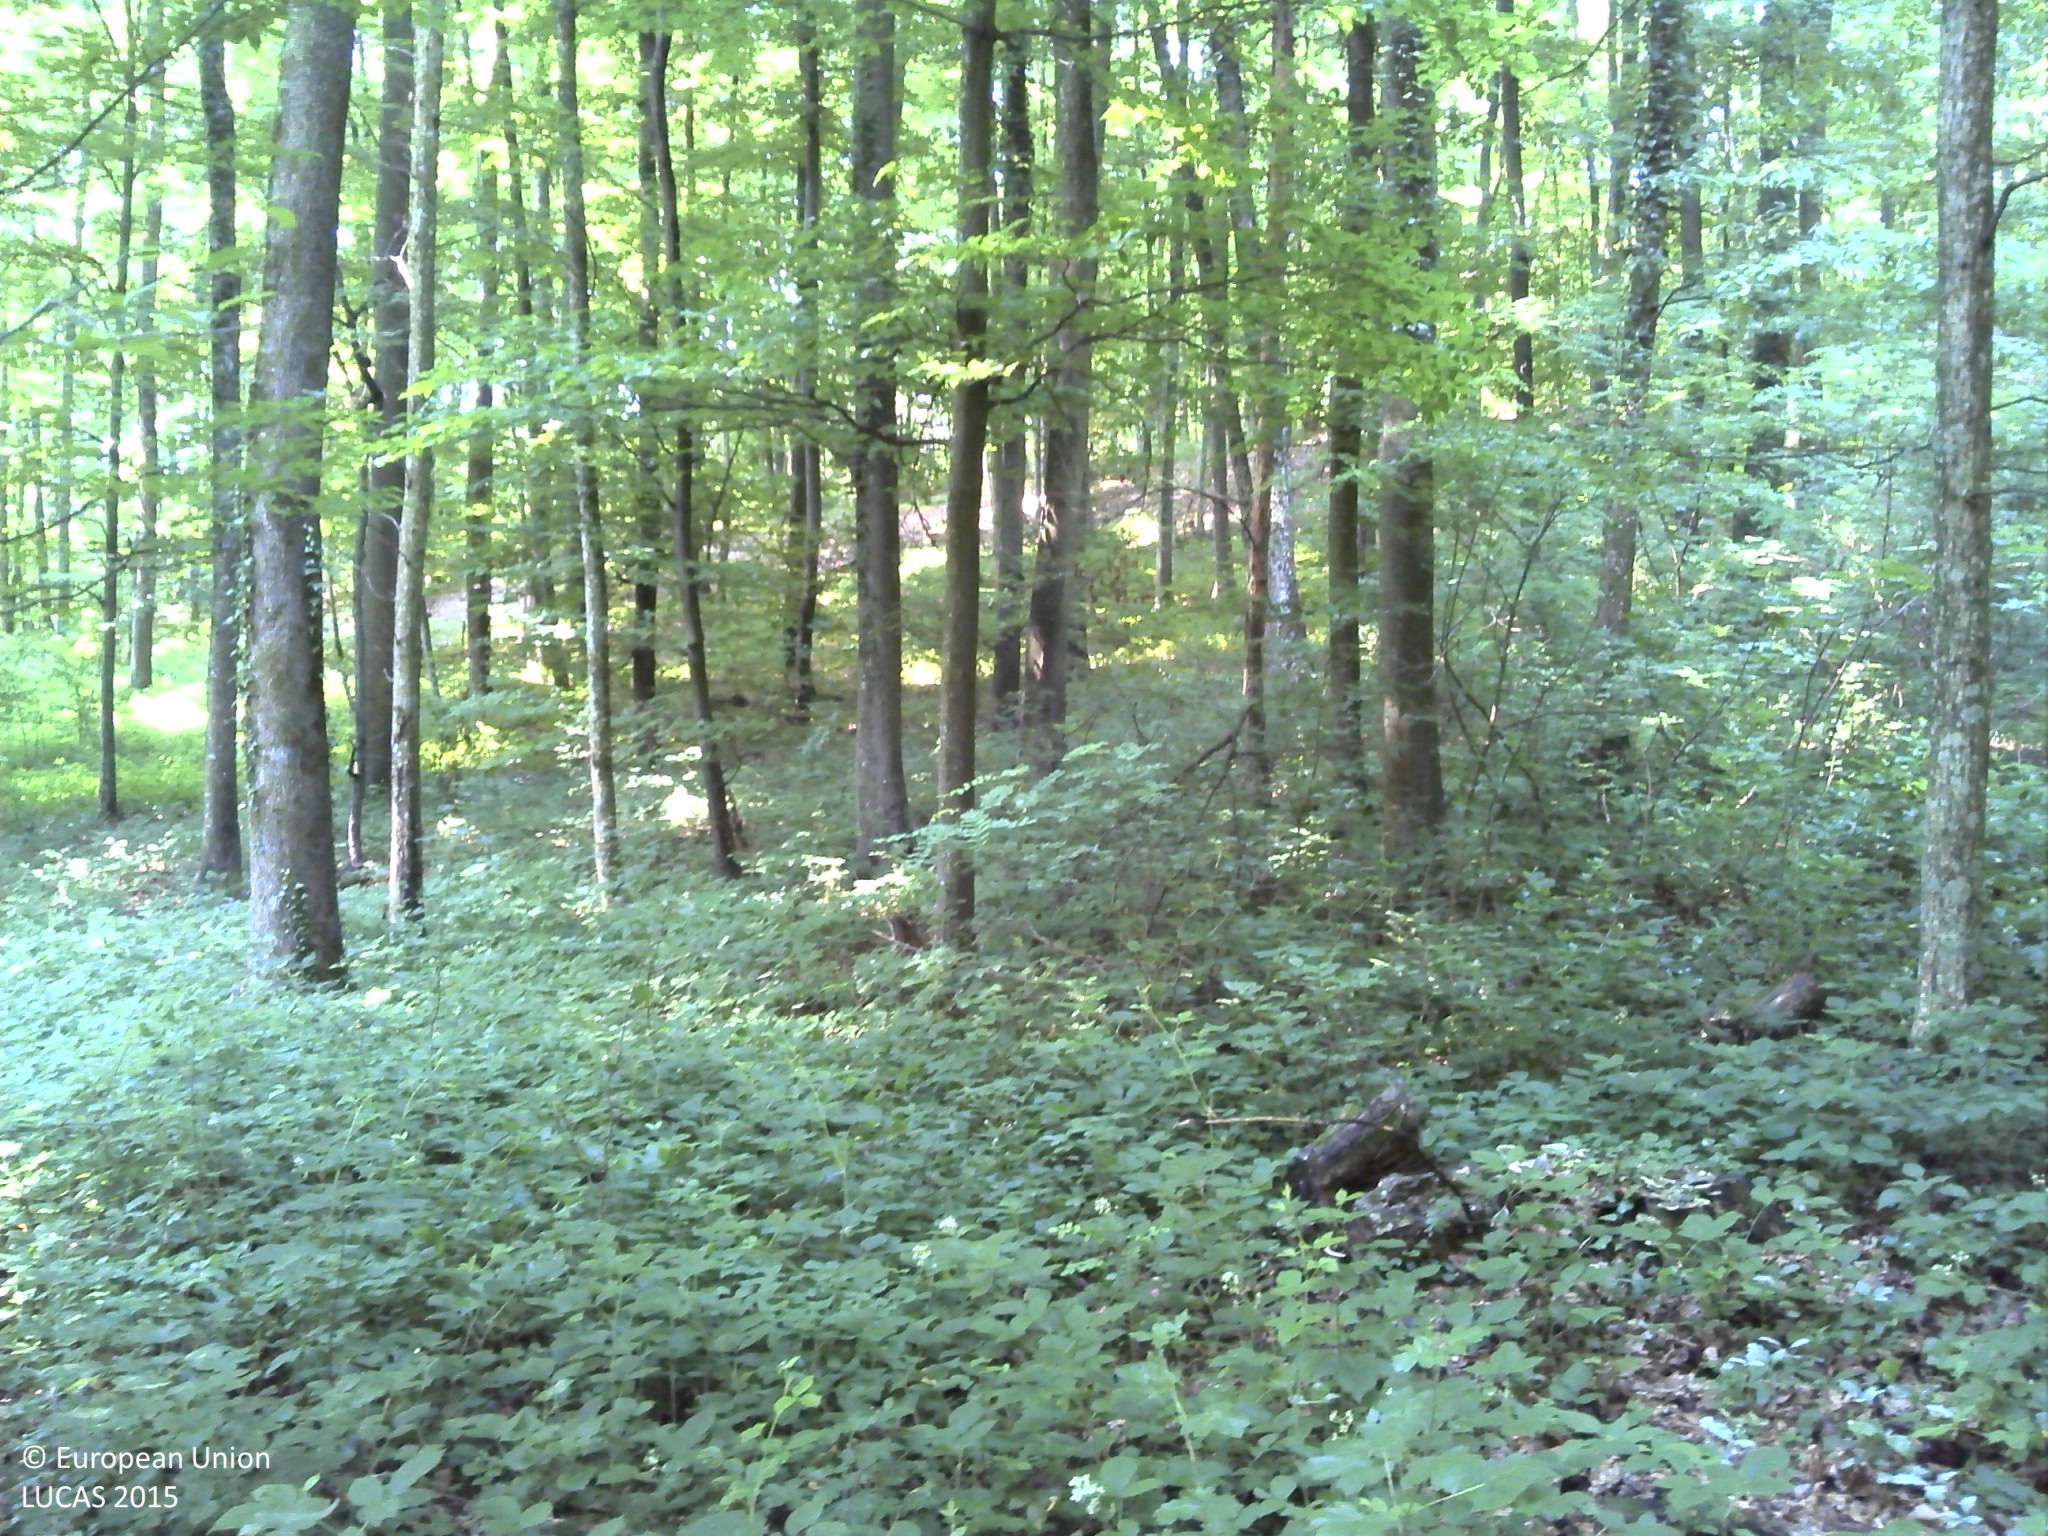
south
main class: Woodland
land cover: Broadleaved woodland
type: beech forest
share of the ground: > 75 %
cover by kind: broadleaved forest trees 90 %, shrubs 5 %, lichens and mosses 5 %
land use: Forestry
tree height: > 5 m
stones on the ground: < 10 %
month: June
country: HR
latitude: 45.2418
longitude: 18.1696
